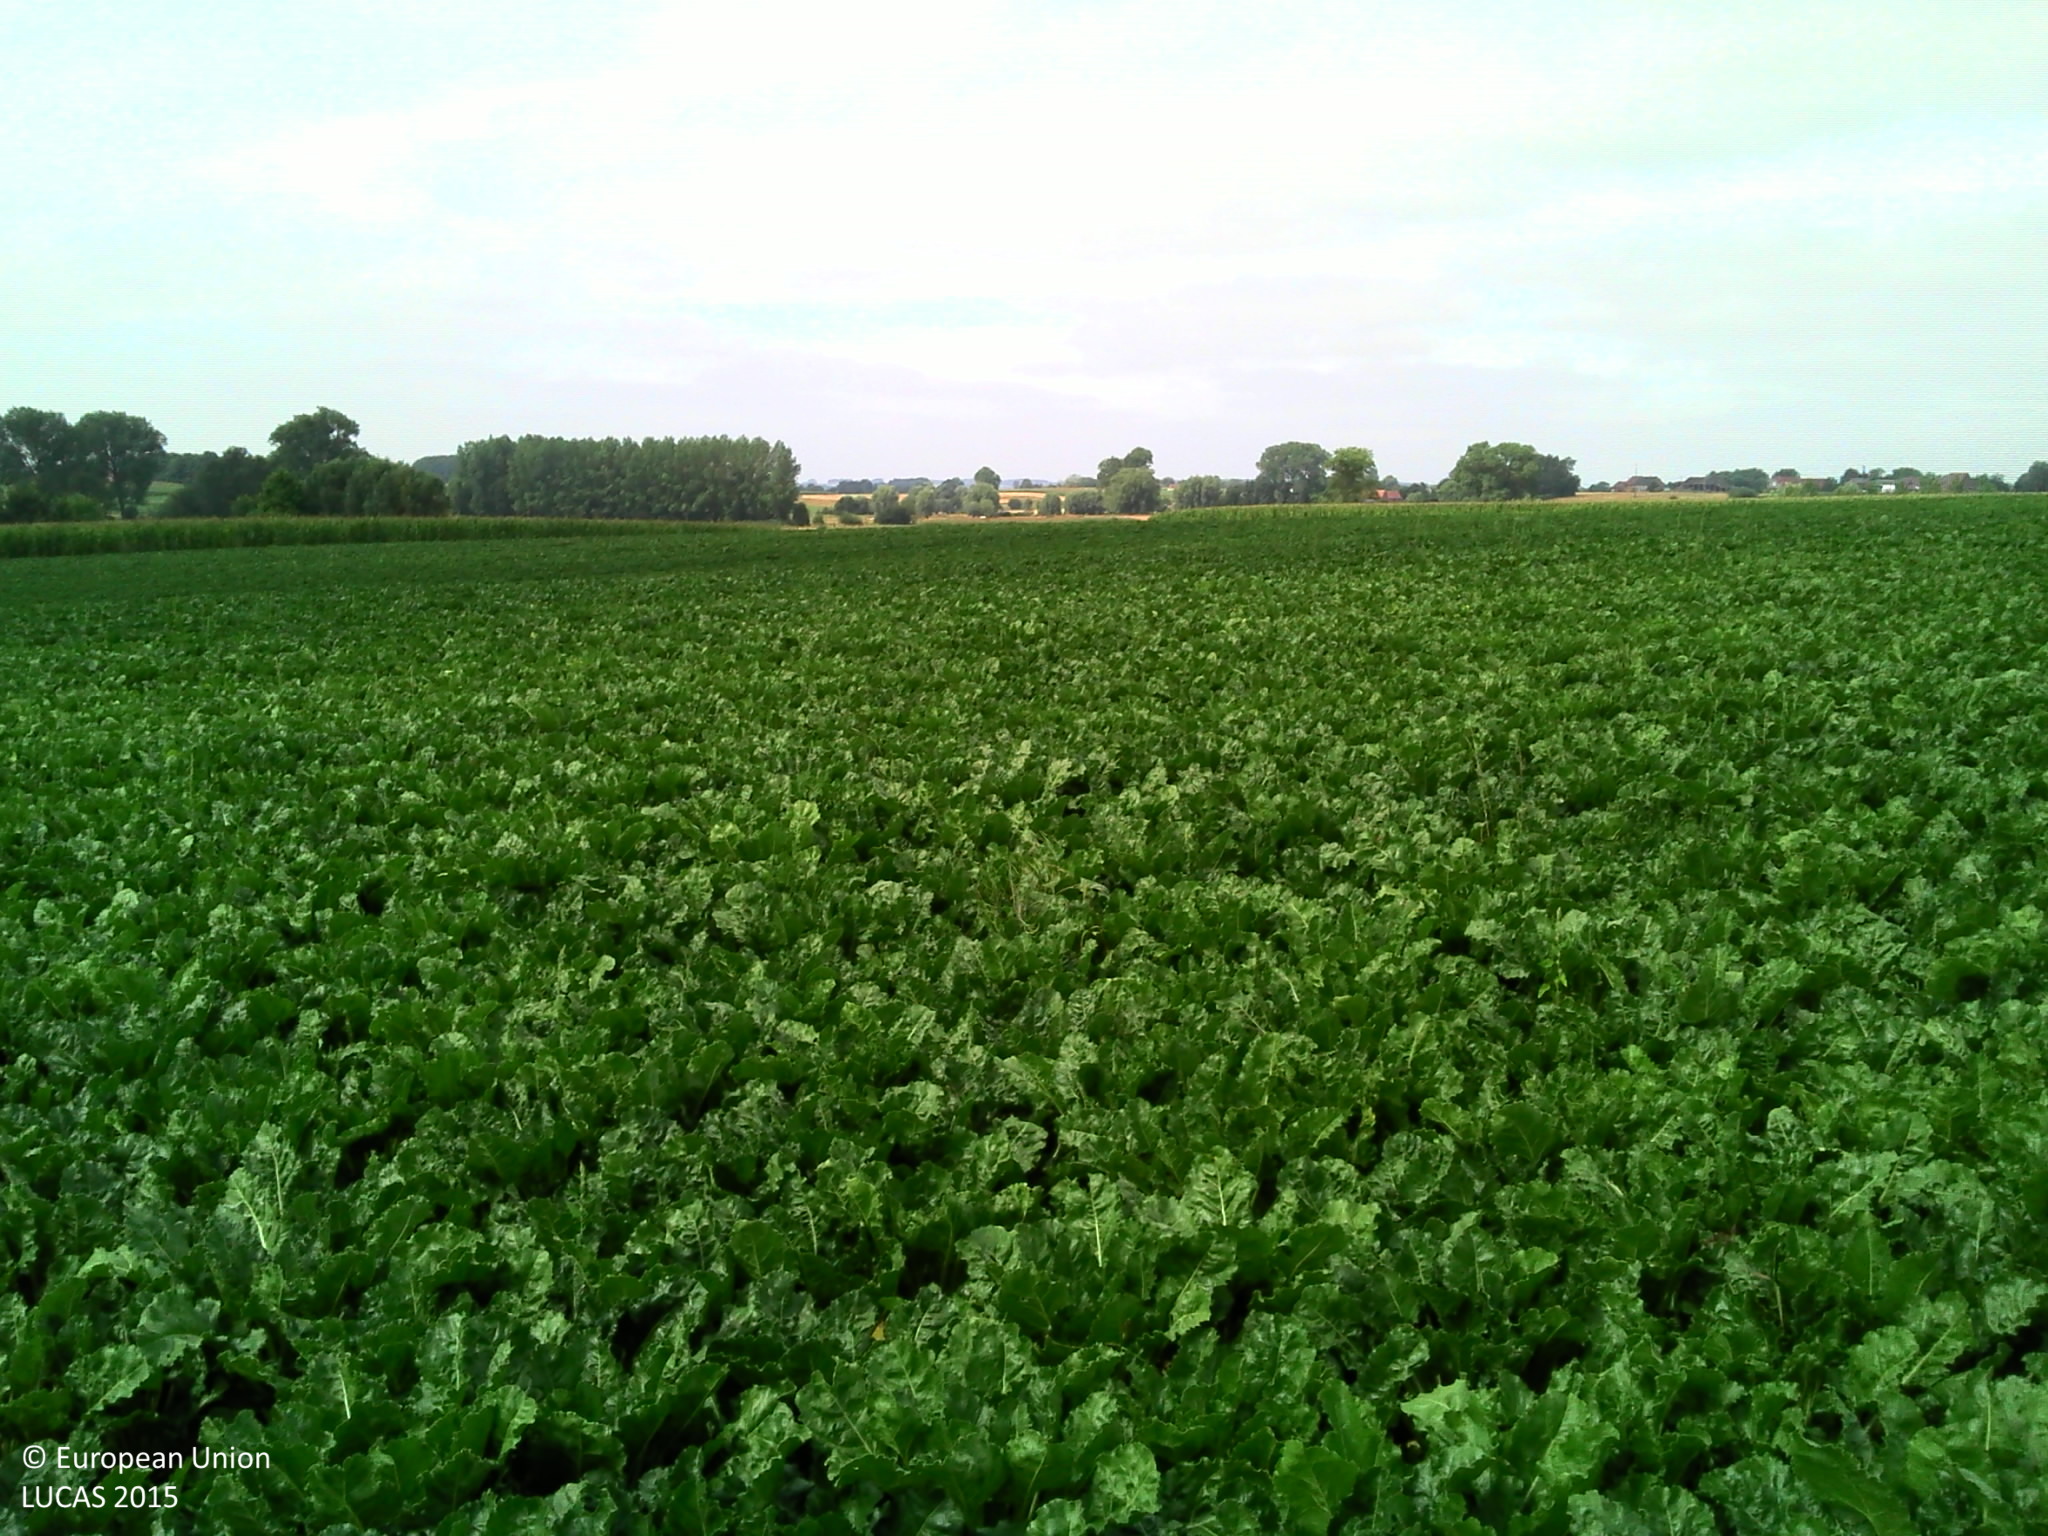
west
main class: Cropland
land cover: Sugar beet
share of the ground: > 75 %
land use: Agriculture (excluding fallow land and kitchen gardens)
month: August
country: BE
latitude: 50.7012
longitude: 3.8061
